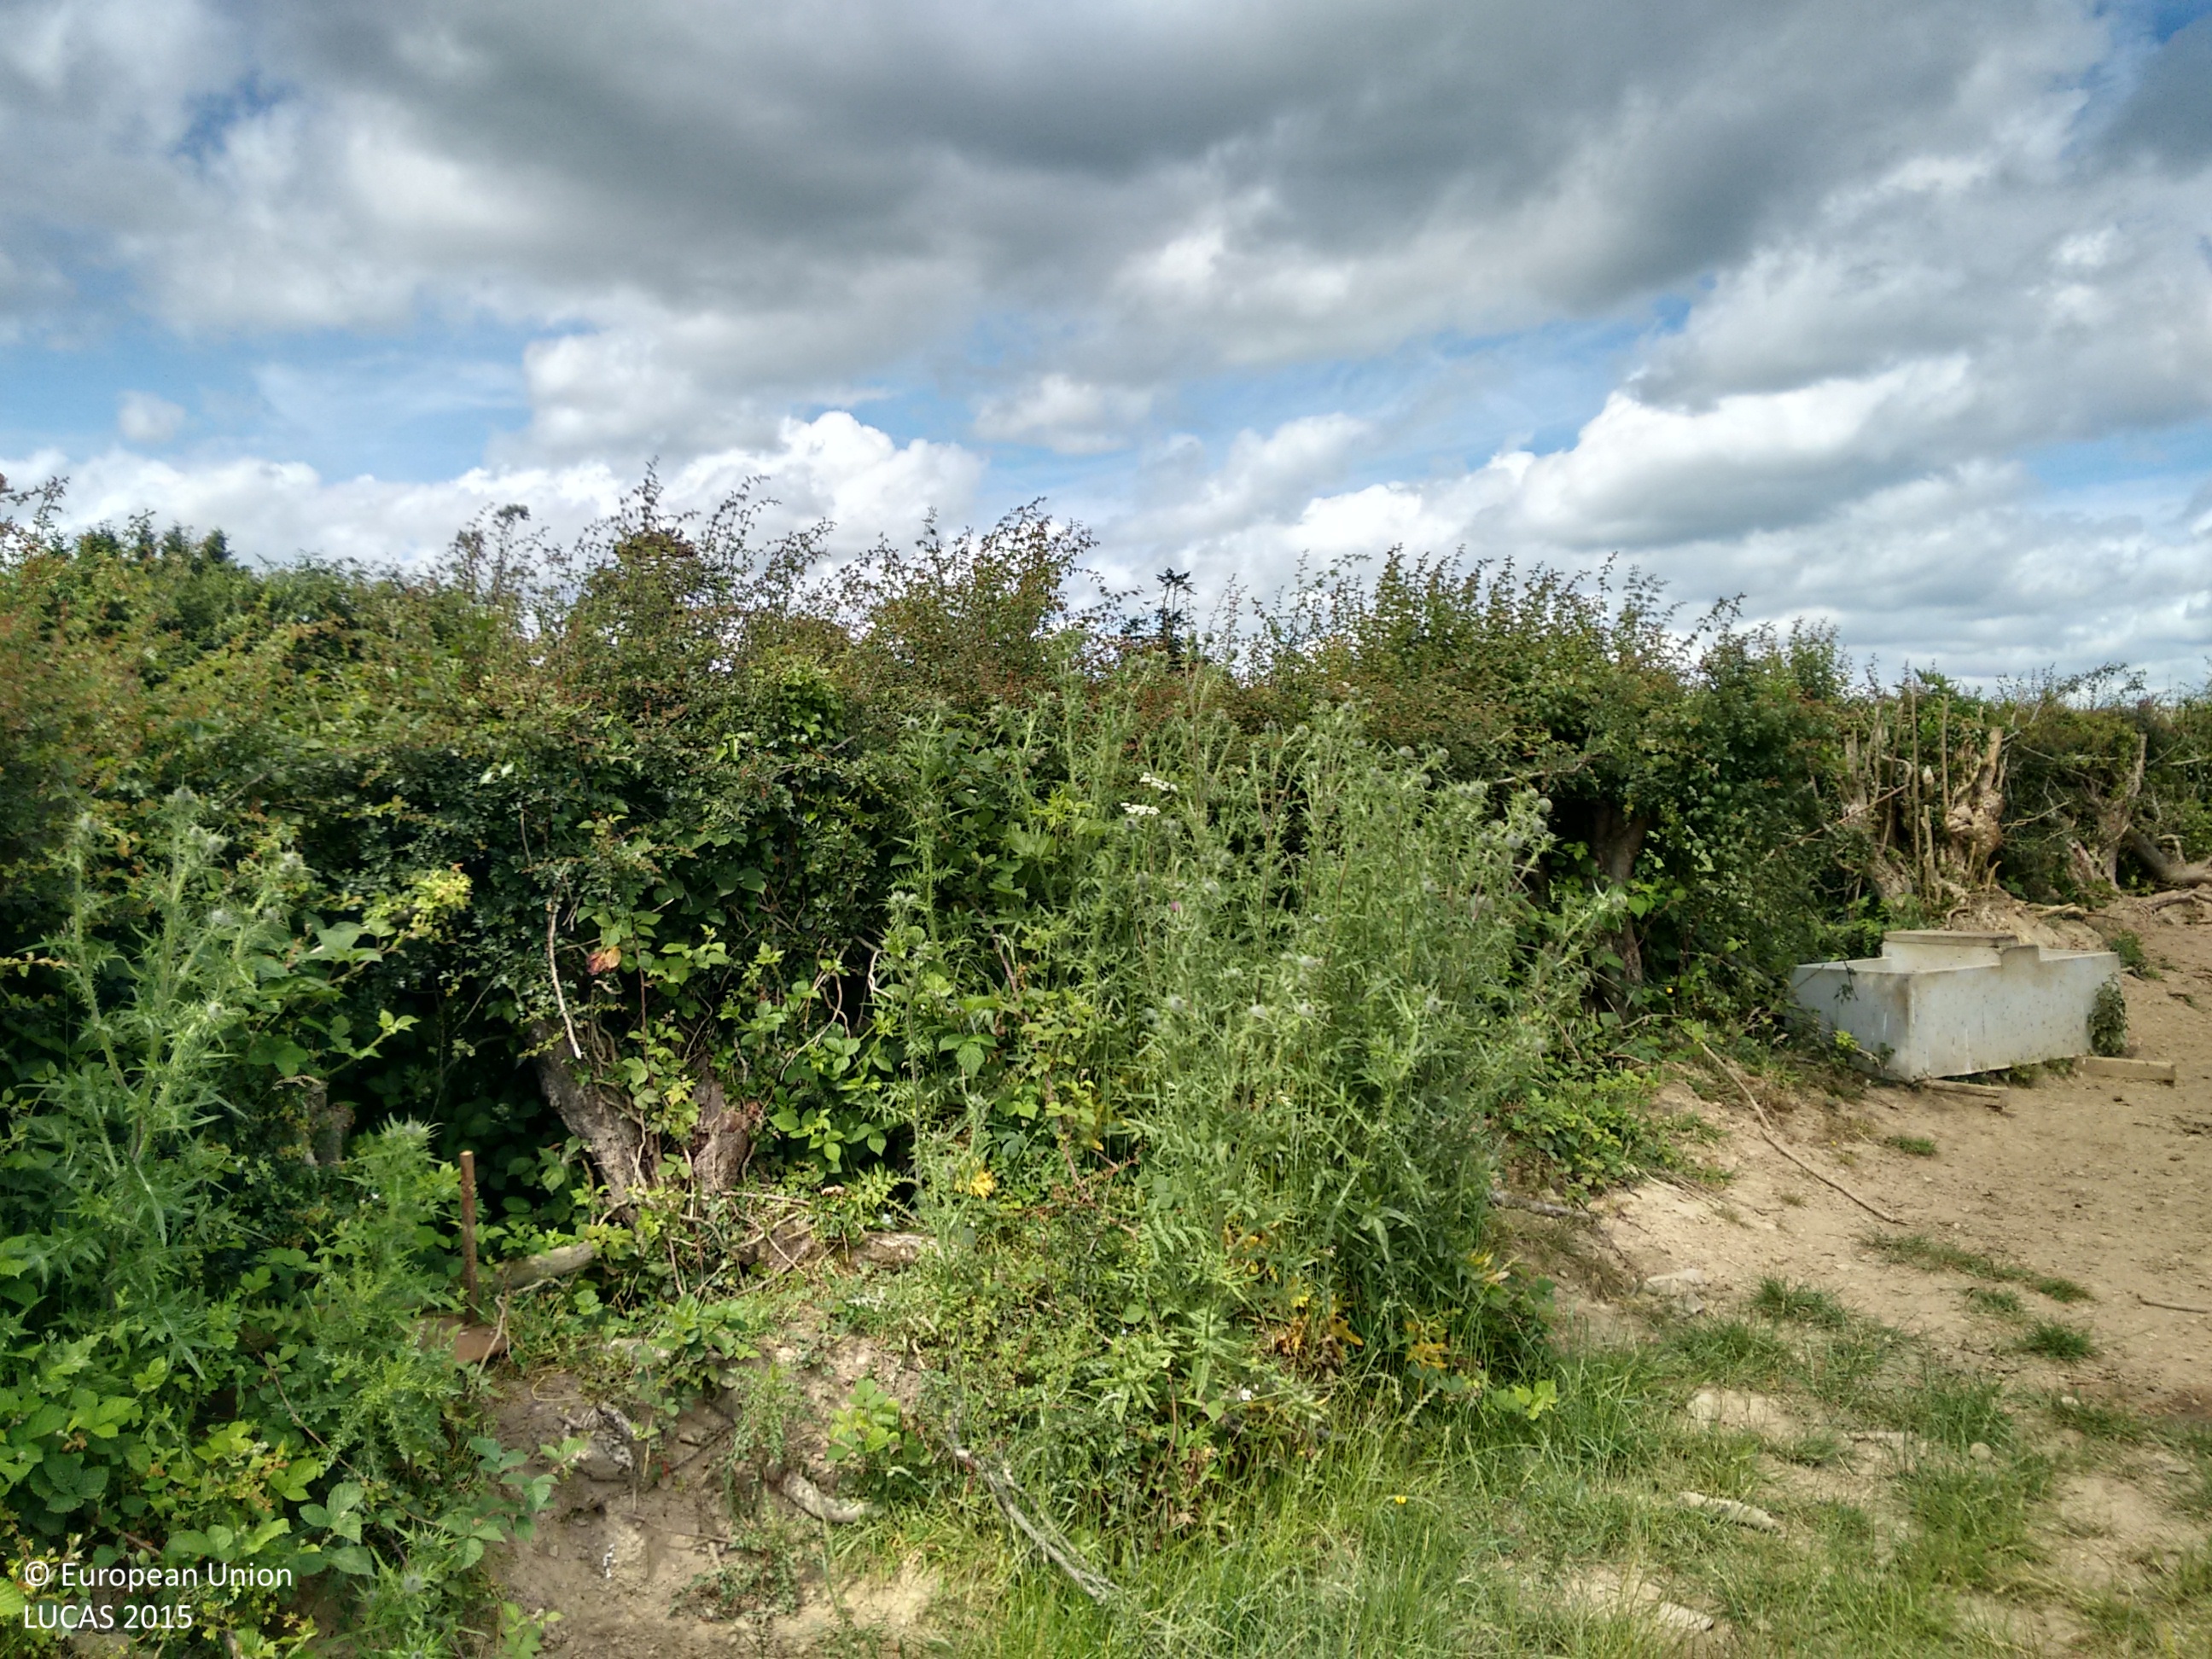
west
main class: Grassland
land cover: Grassland without tree/shrub cover
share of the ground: > 75 %
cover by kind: herbaceous plants 100 %
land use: Agriculture (excluding fallow land and kitchen gardens)
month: July
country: IE
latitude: 53.7991
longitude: -6.7901
